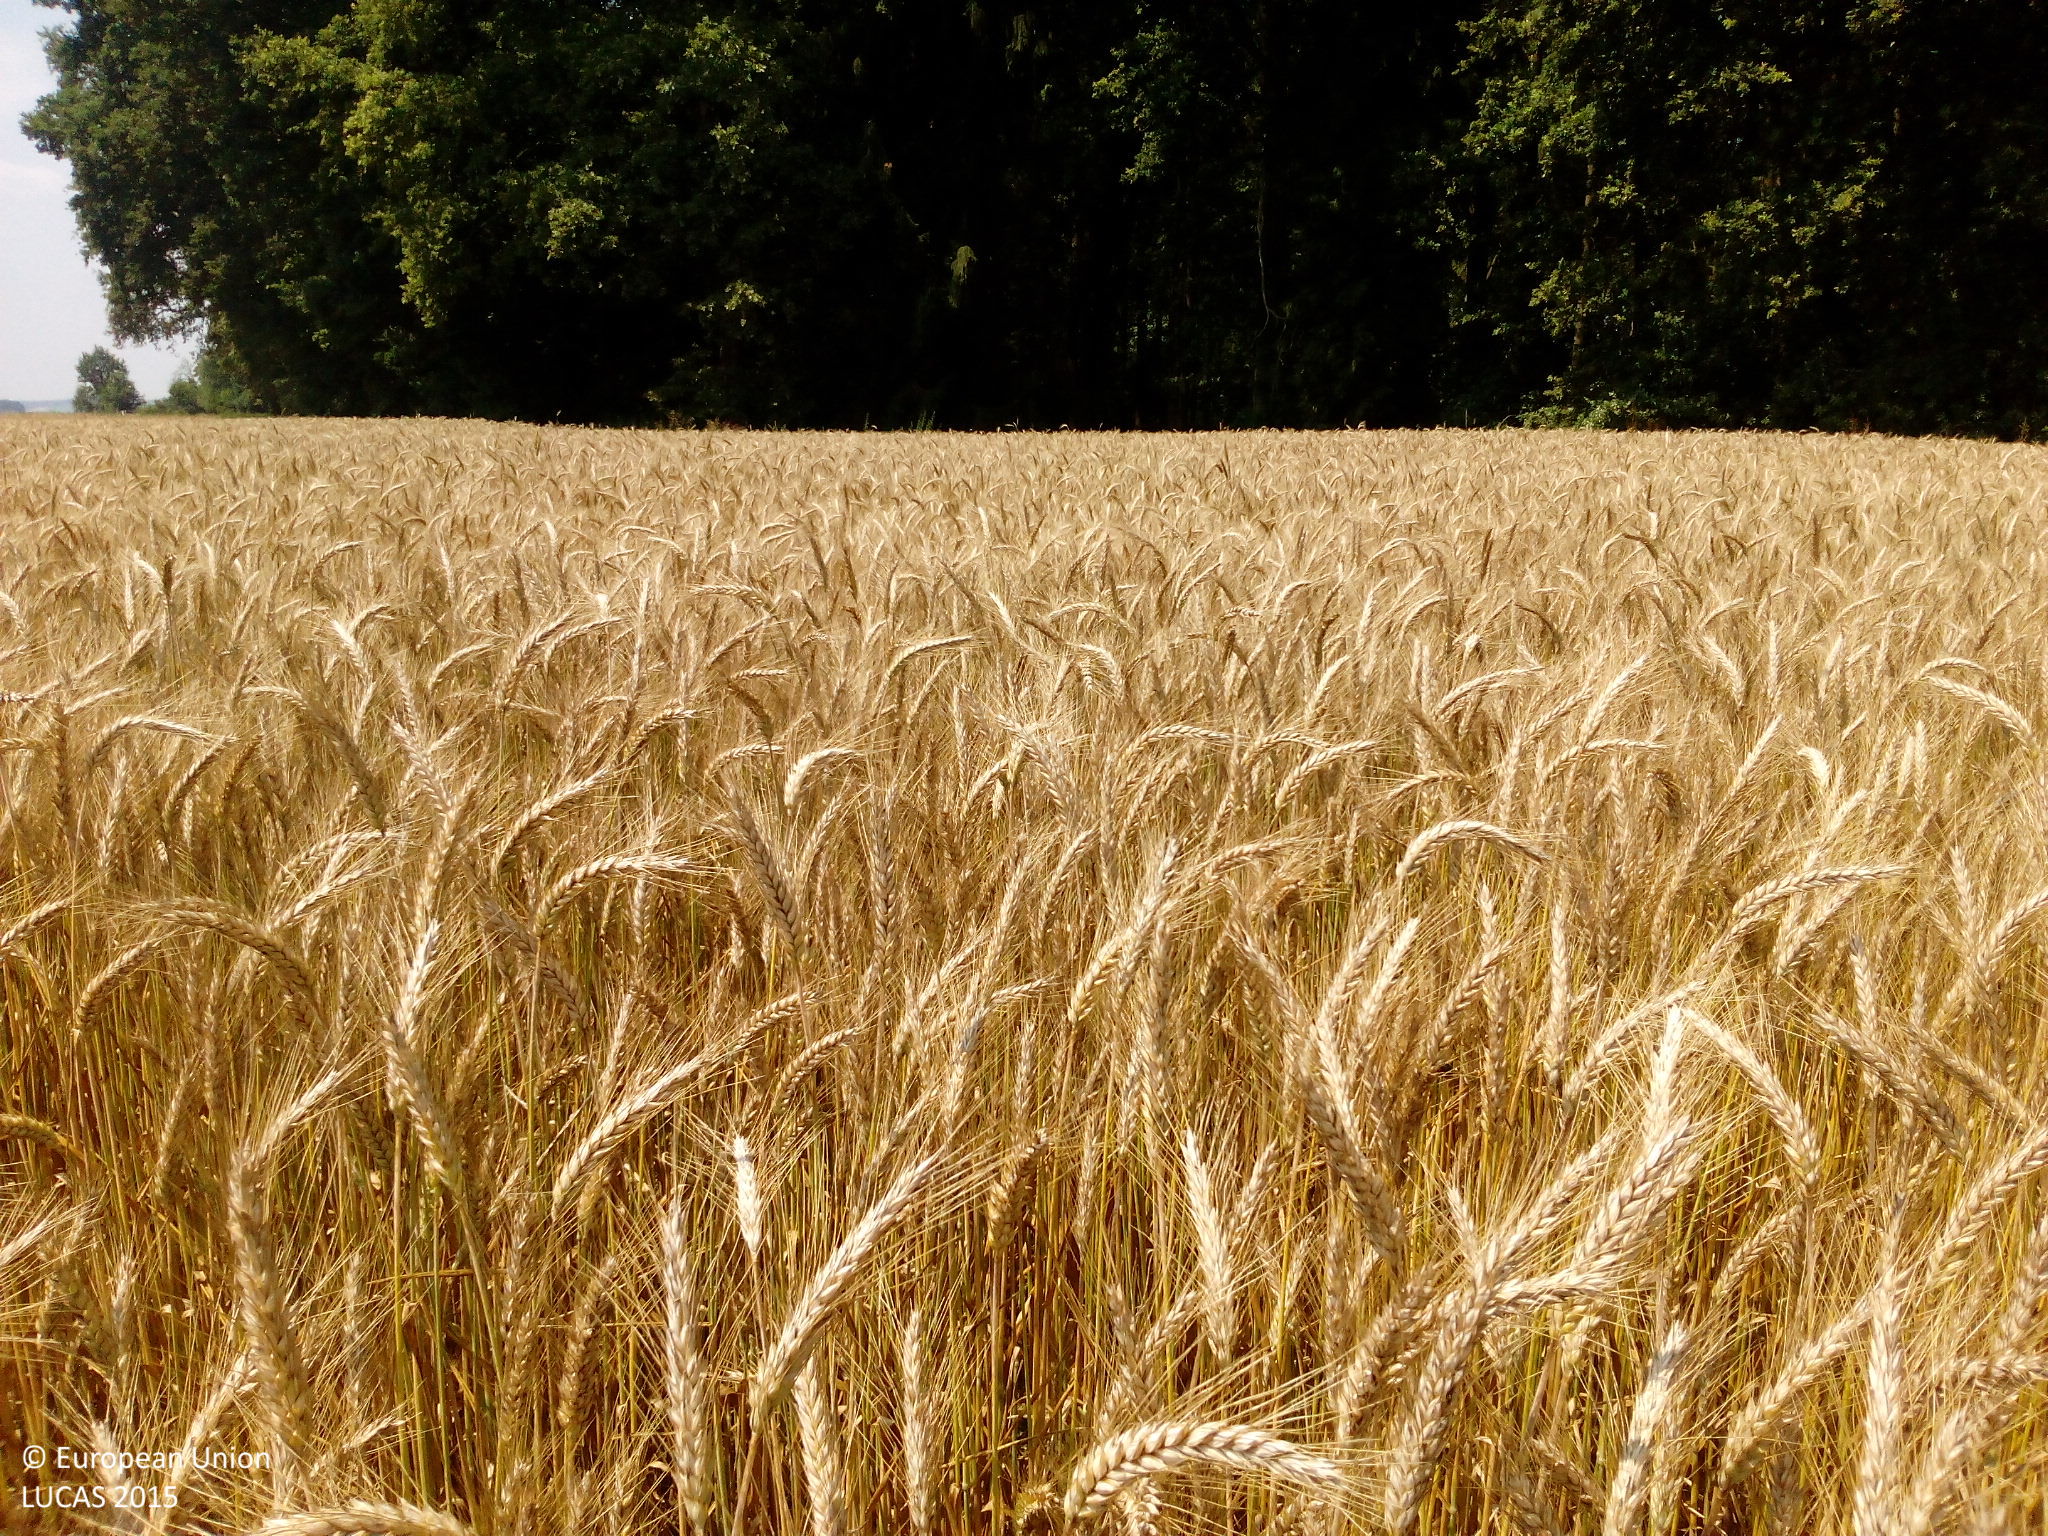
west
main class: Cropland
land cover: Rye
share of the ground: > 75 %
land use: Agriculture (excluding fallow land and kitchen gardens)
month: July
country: DE
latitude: 48.8008
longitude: 11.9190
